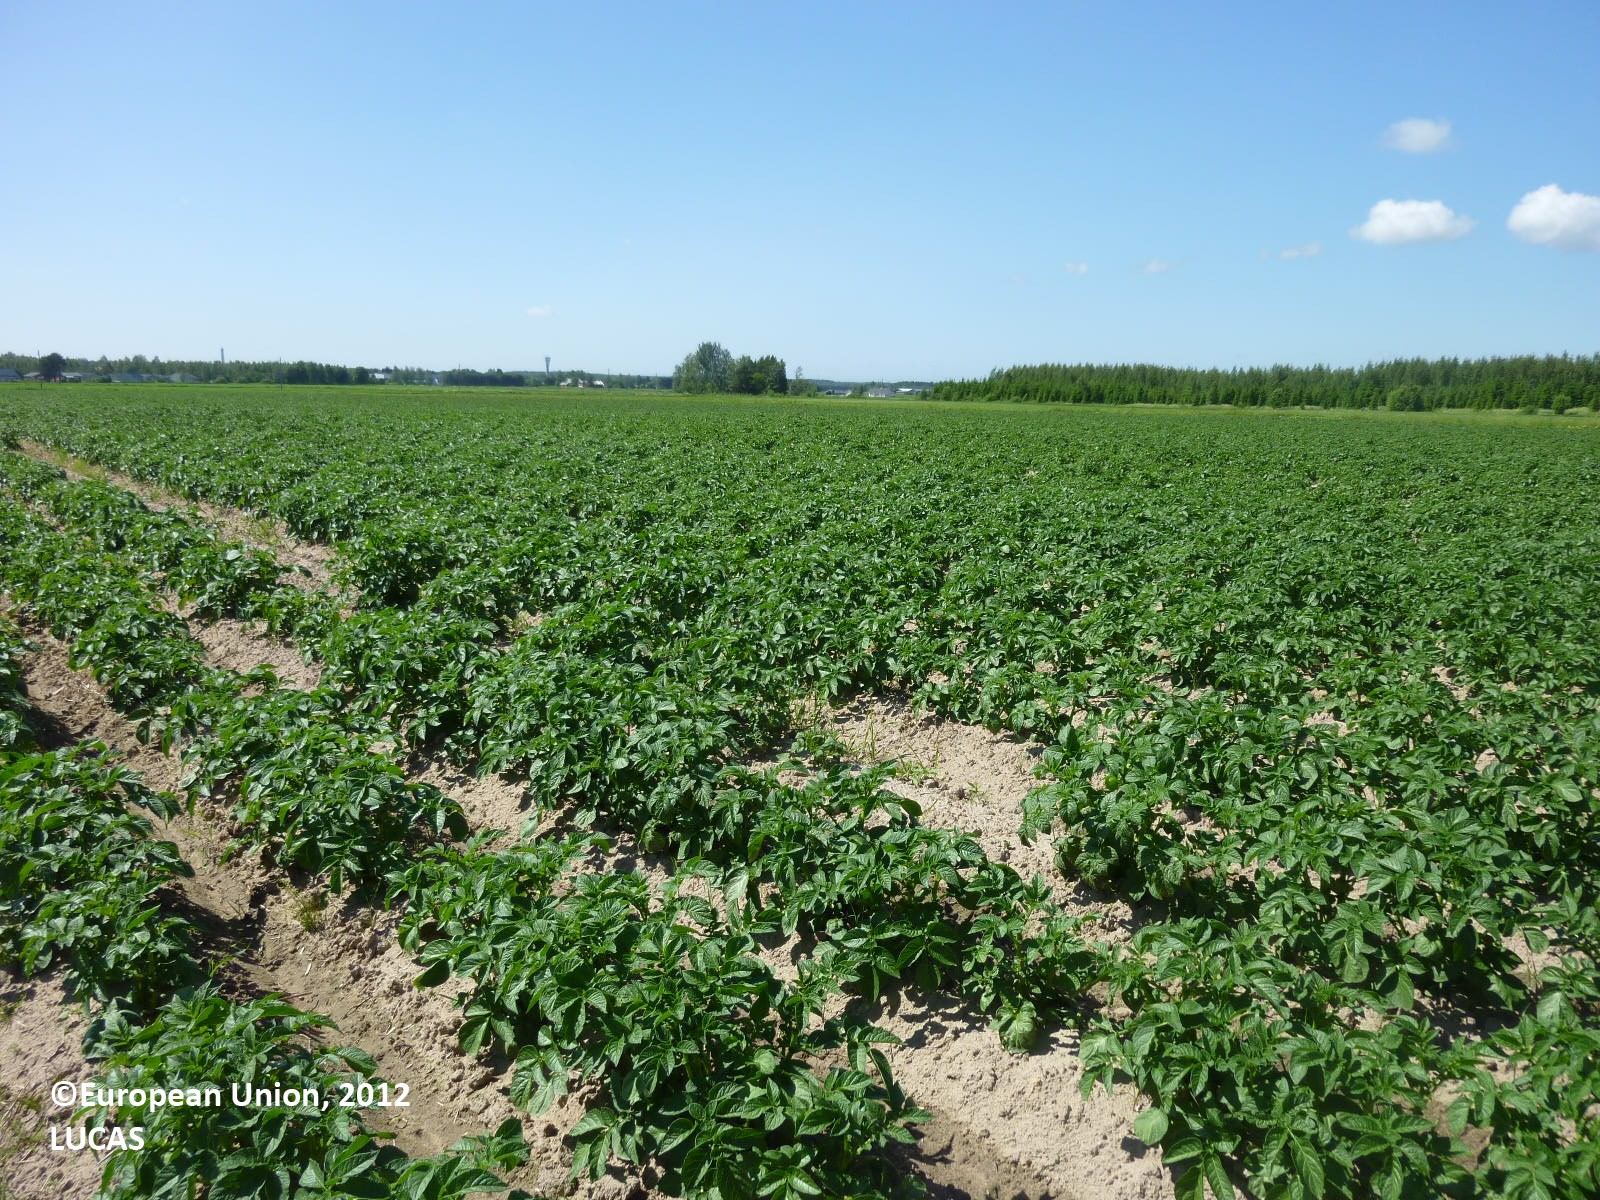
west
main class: Cropland
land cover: Potatoes
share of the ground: 25 - 50 %
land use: Agriculture (excluding fallow land and kitchen gardens)
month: July
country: FI
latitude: 61.3772
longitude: 22.0532
